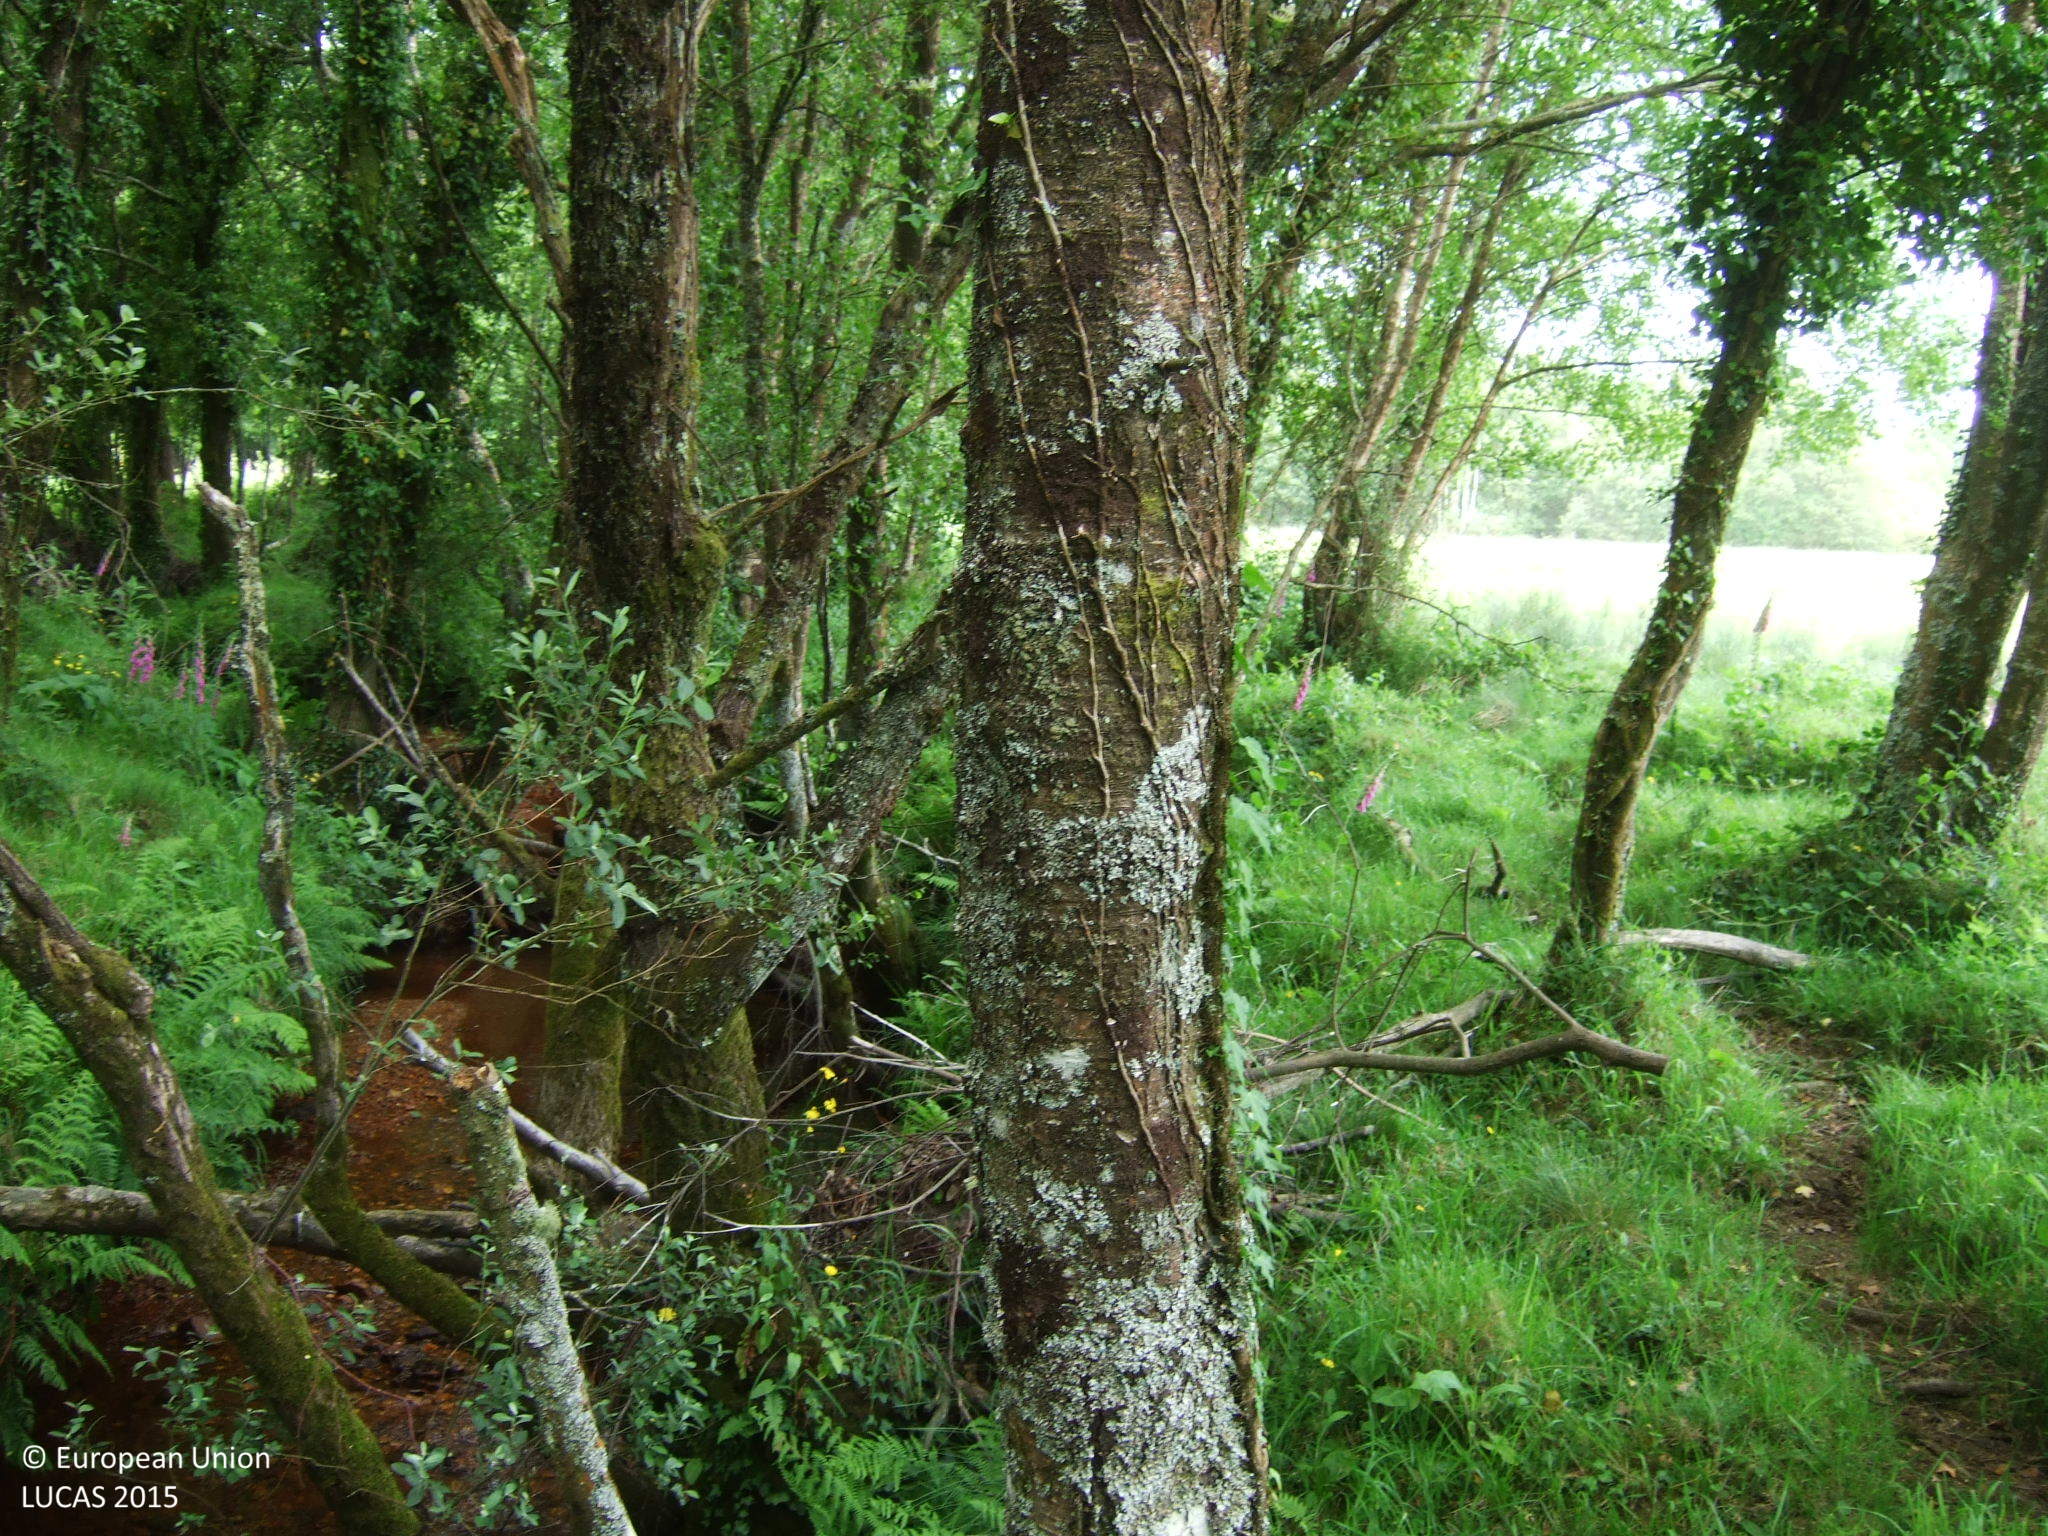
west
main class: Woodland
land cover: Broadleaved woodland
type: floodplain forest
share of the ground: 50 - 75 %
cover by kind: broadleaved forest trees 70 %, herbaceous plants 20 %, shrubs 10 %
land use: Semi-natural and natural areas not in use
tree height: > 5 m
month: June
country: ES
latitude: 43.4033
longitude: -7.8083
